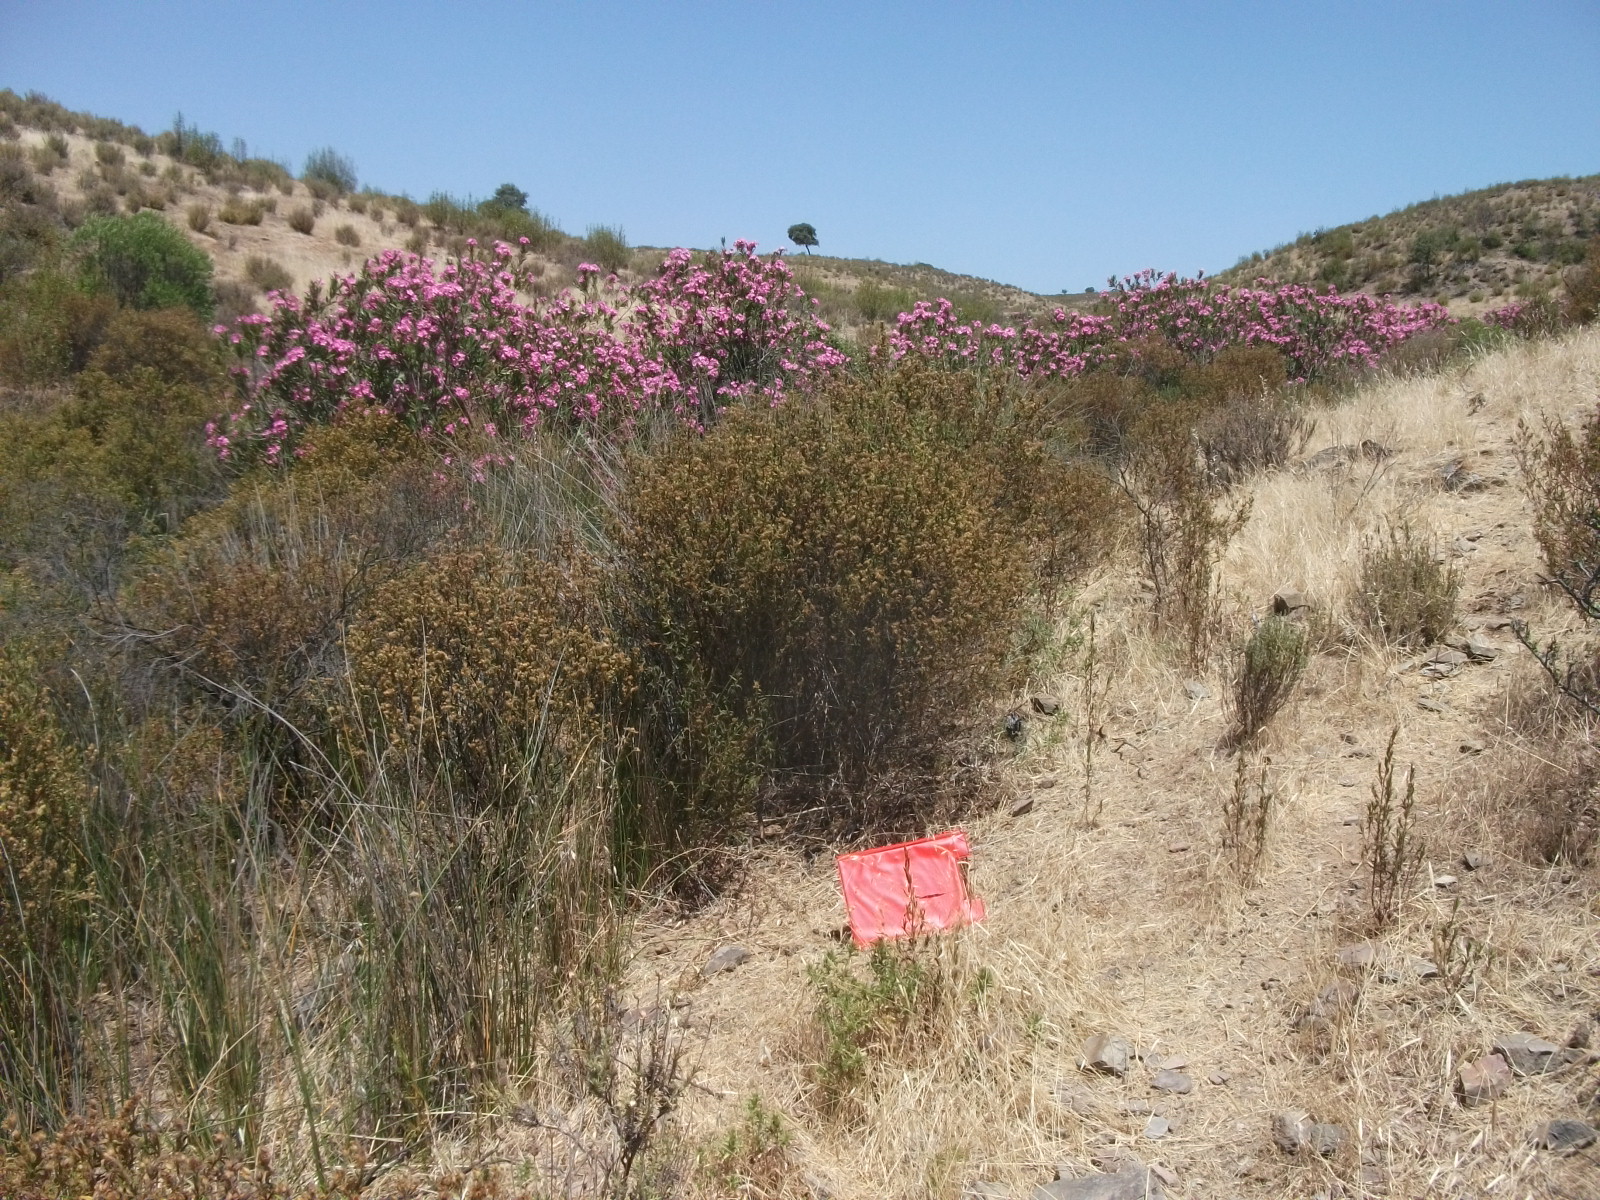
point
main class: Shrubland
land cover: Shrubland without tree cover
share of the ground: 25 - 50 %
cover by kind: shrubs 45 %, herbaceous plants 40 %, unconsolidated bare surface 15 %
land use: Agriculture (excluding fallow land and kitchen gardens)
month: June
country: ES
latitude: 37.5670
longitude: -6.9246
